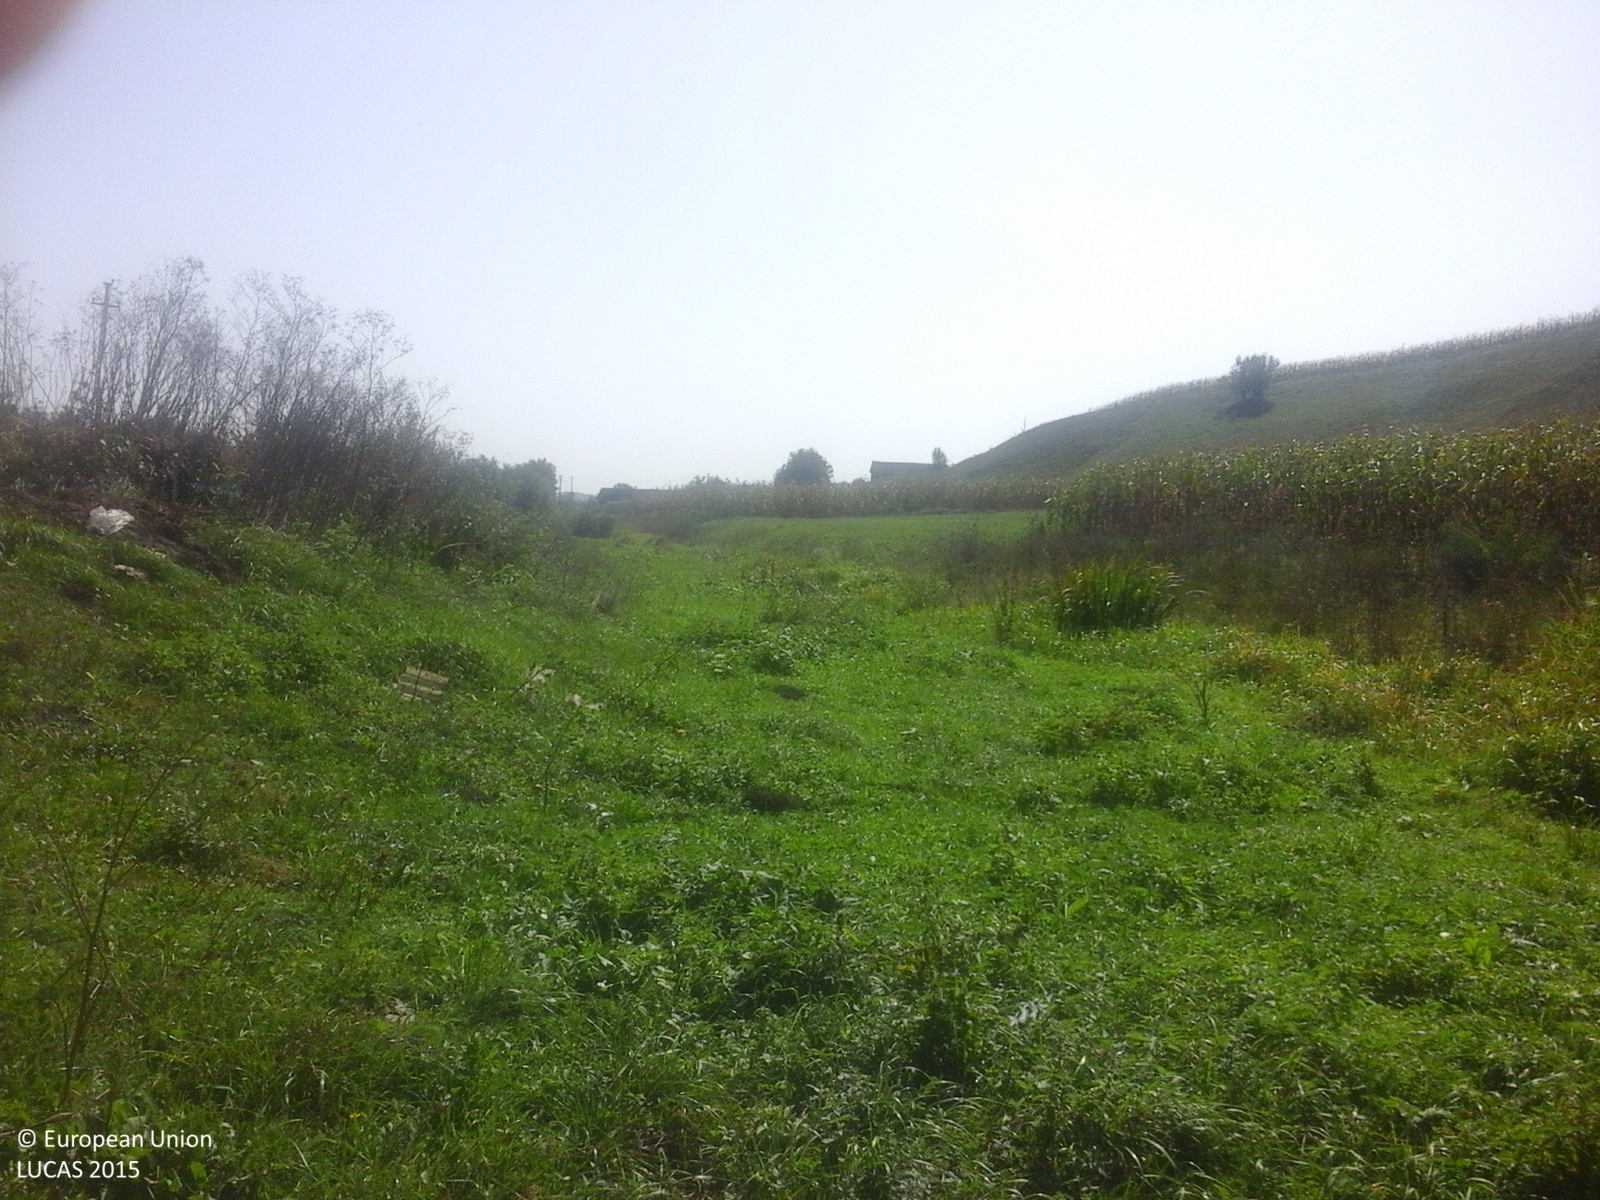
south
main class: Cropland
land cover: Maize
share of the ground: > 75 %
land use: Agriculture (excluding fallow land and kitchen gardens)
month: September
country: RO
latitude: 46.7249
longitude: 24.2536
